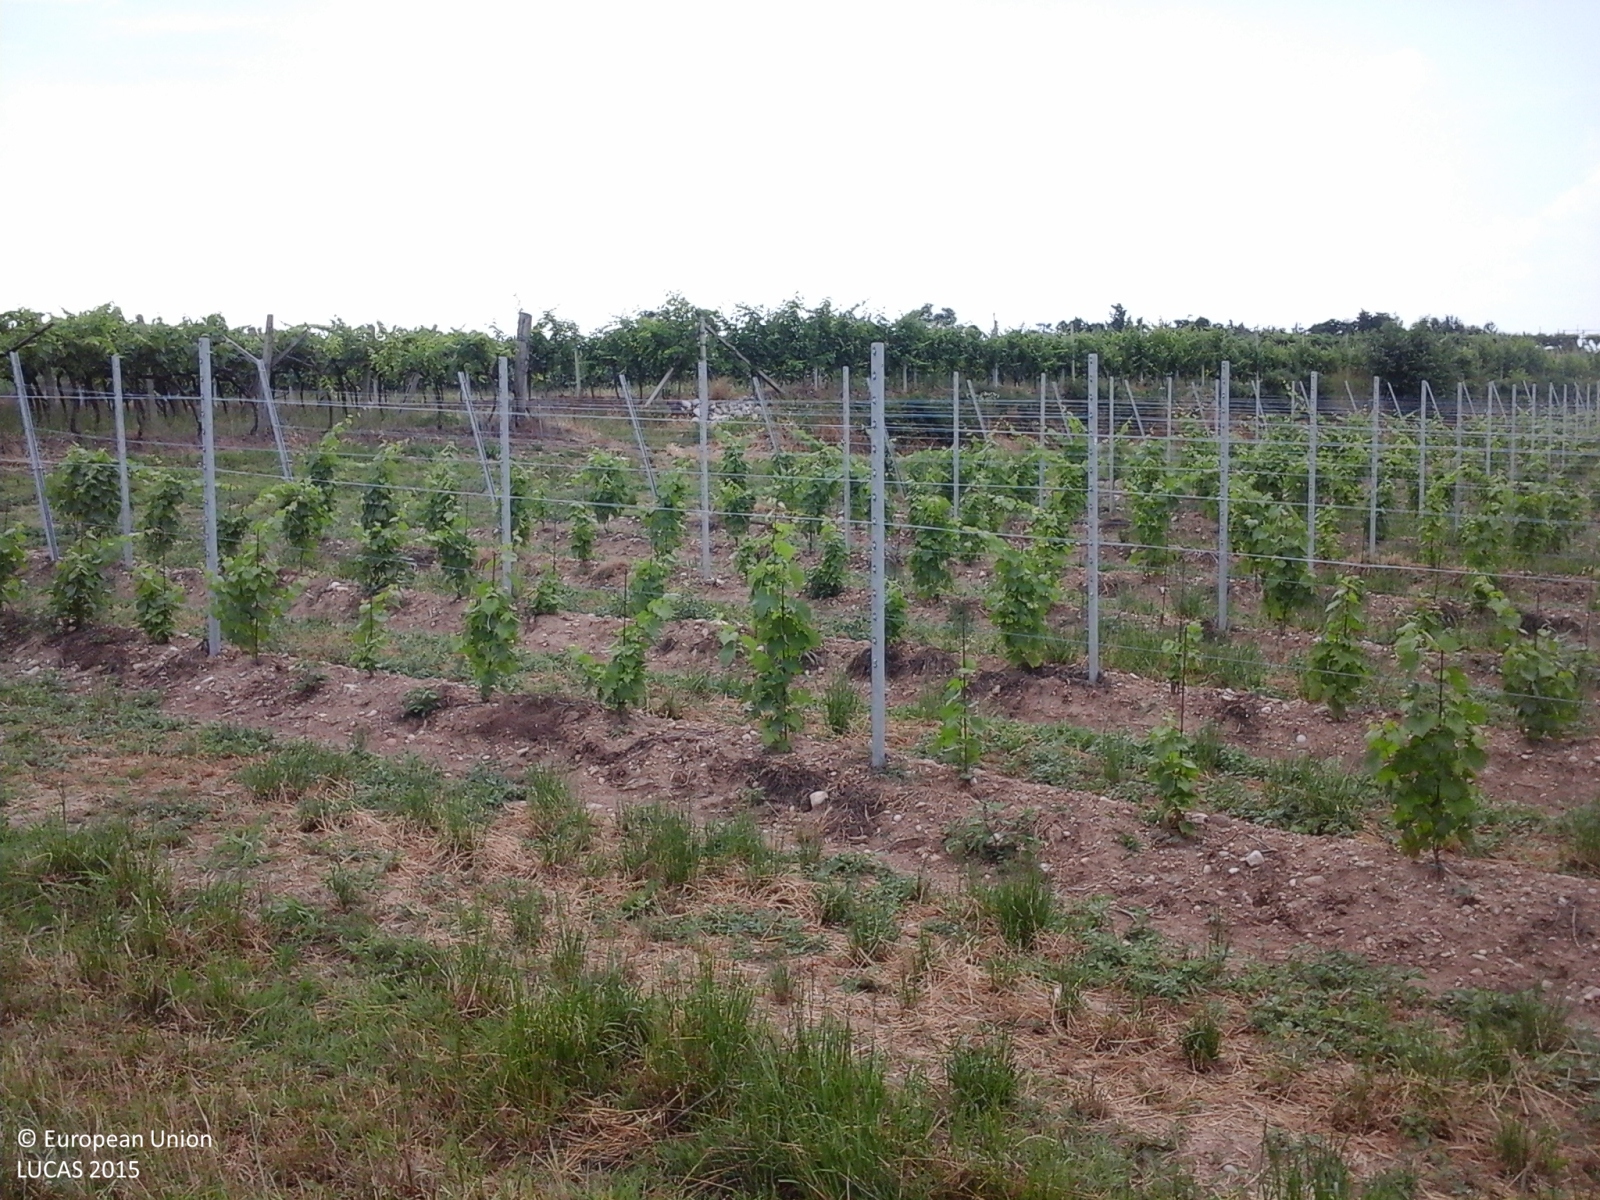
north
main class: Cropland
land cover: Vineyards
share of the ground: > 75 %
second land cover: Grassland without tree/shrub cover
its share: > 75 %
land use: Agriculture (excluding fallow land and kitchen gardens)
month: June
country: IT
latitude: 45.4293
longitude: 10.8039
